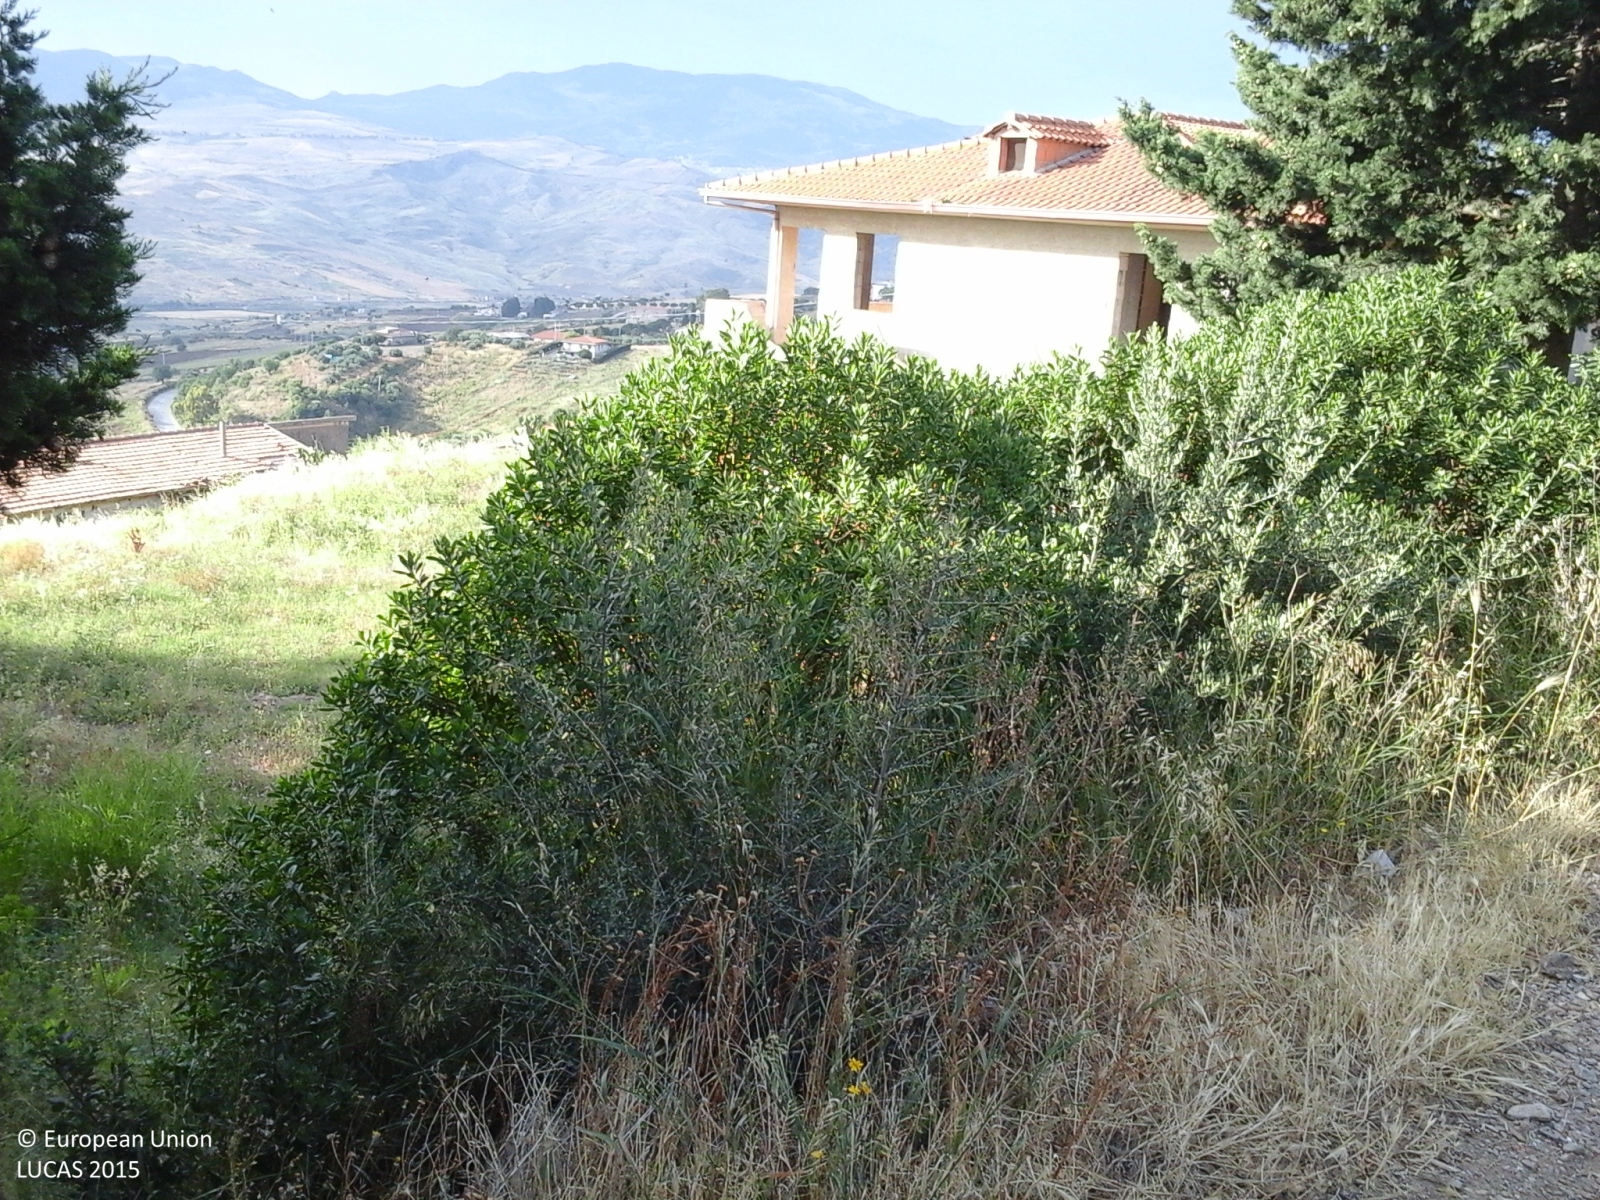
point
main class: Grassland
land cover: Grassland with sparse tree/shrub cover
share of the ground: > 75 %
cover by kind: herbaceous plants 85 %, shrubs 10 %, broadleaved forest trees 5 %
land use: Agriculture (excluding fallow land and kitchen gardens)
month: June
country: IT
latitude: 37.9275
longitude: 13.7618
